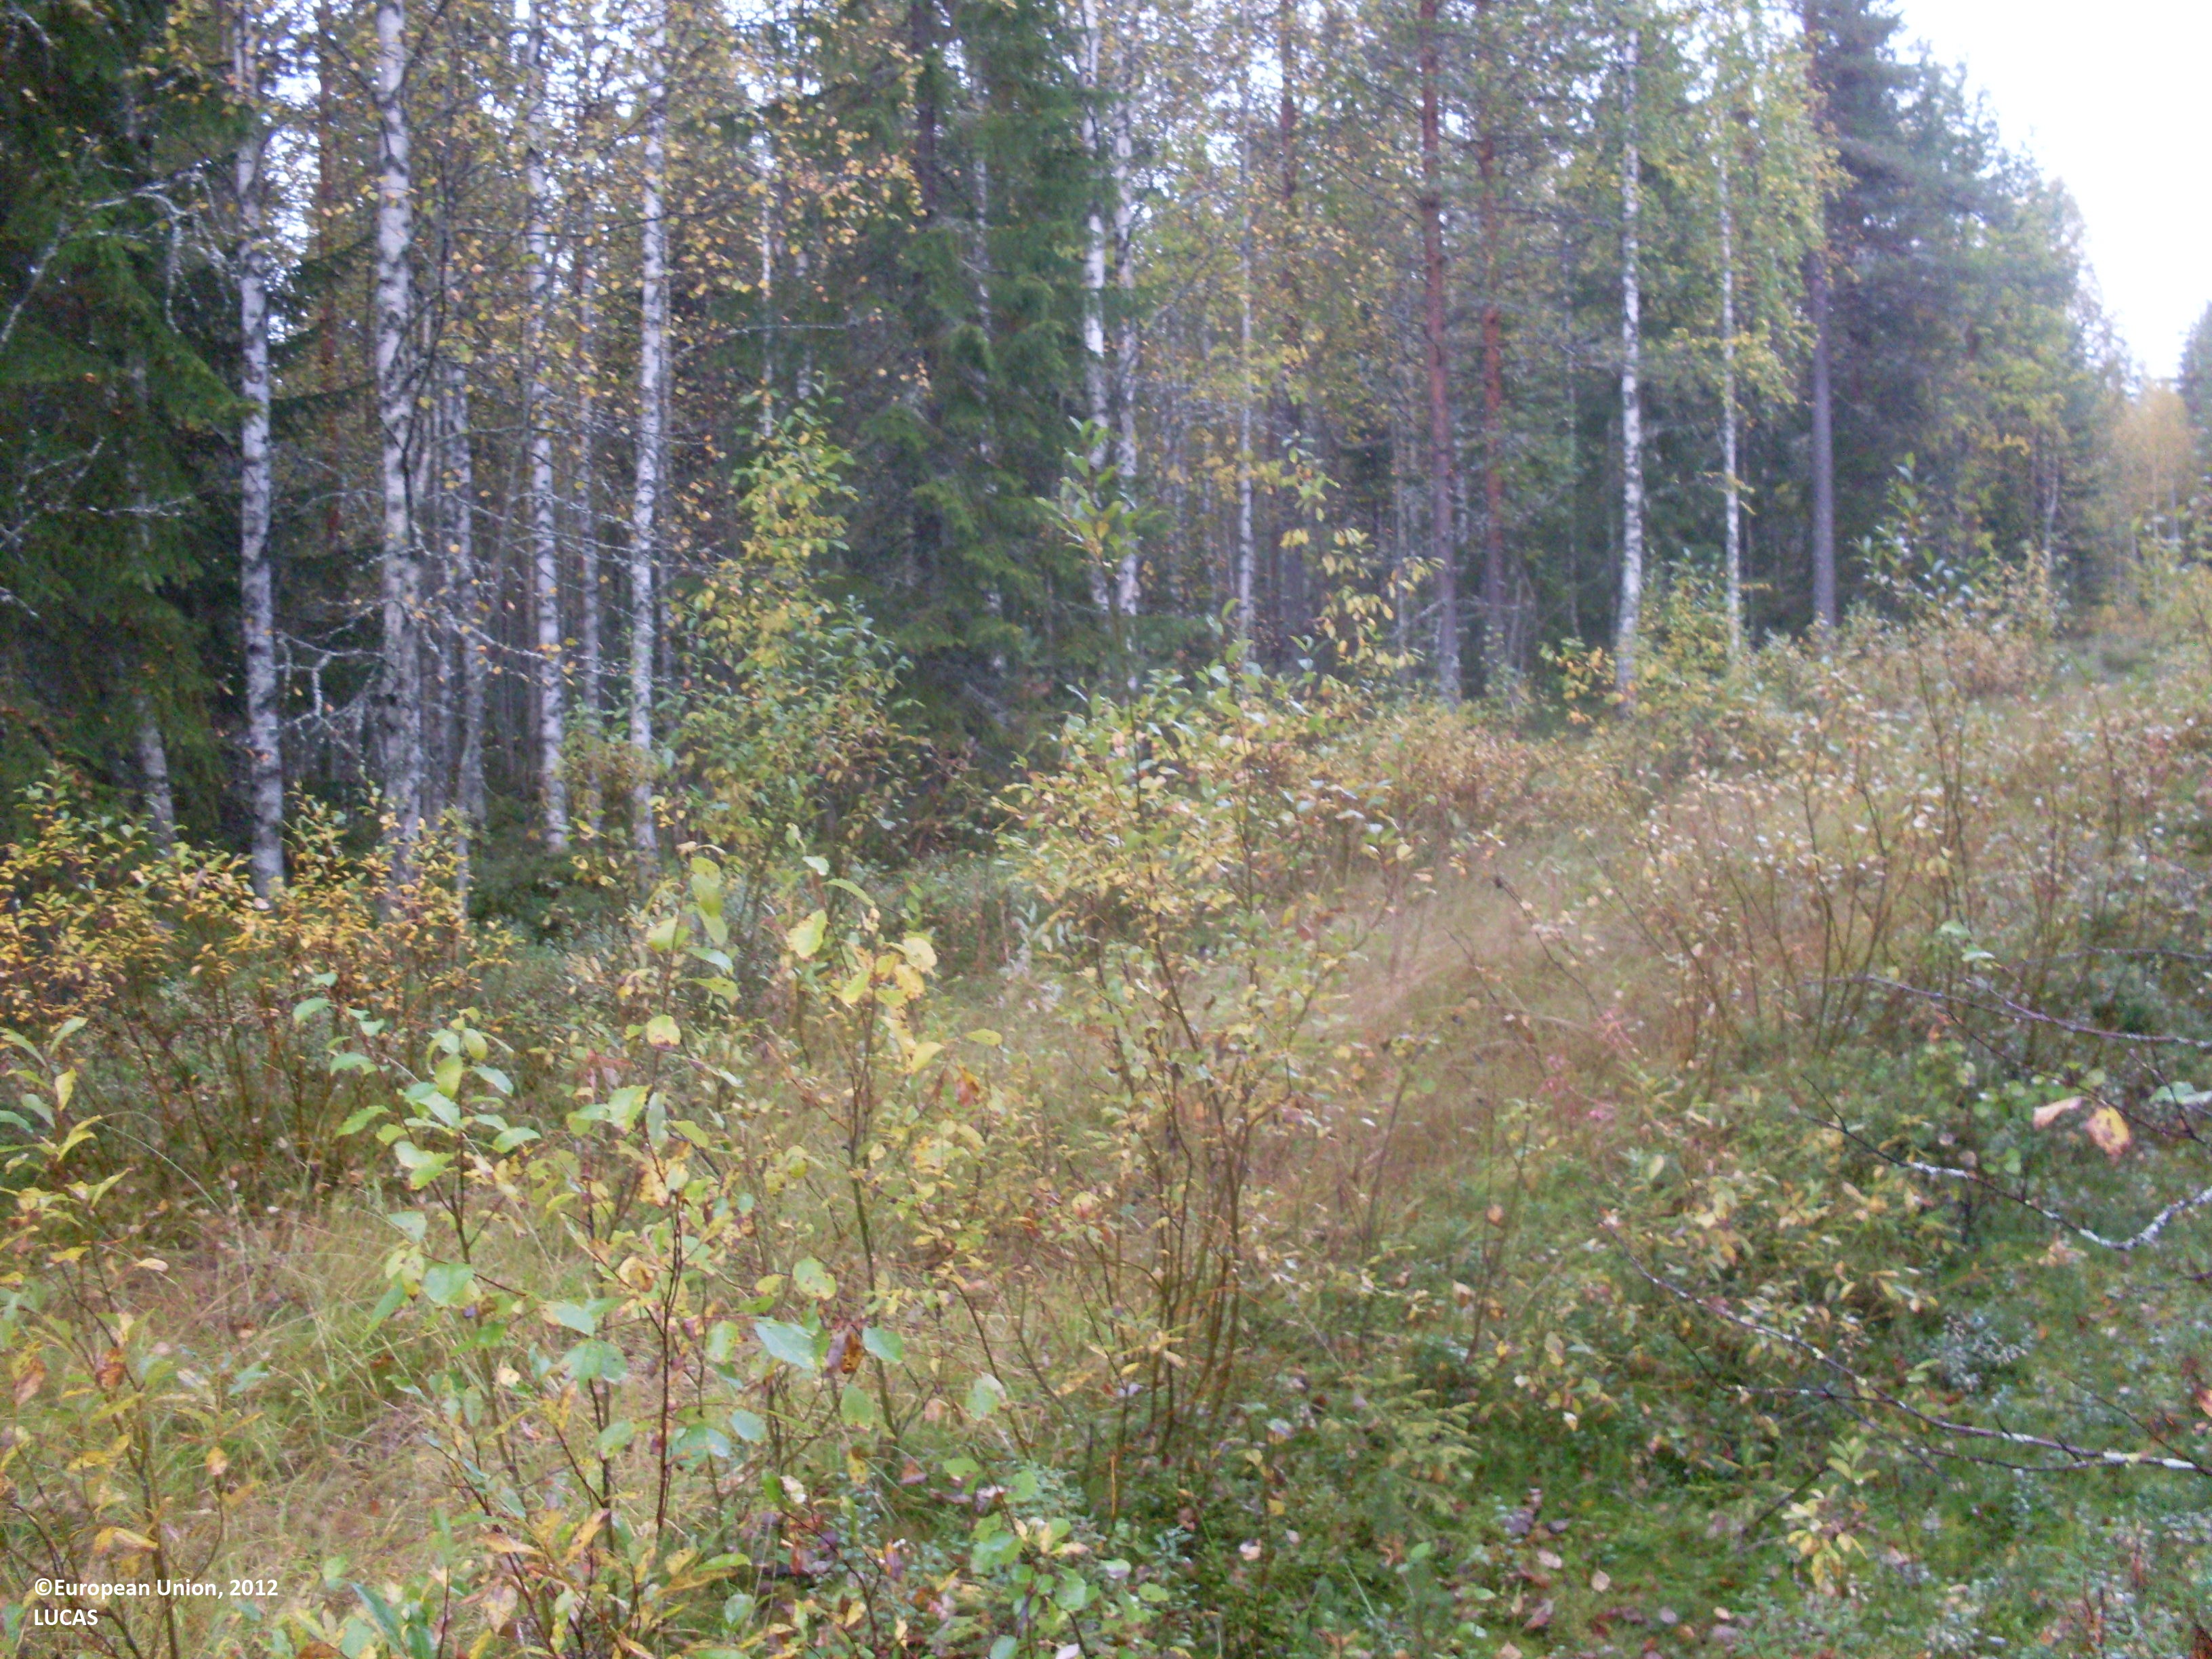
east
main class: Woodland
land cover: Other mixed woodland
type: boreal forest
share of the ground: > 75 %
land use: Forestry
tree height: > 5 m
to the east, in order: Other mixed woodland; Tracks; Other mixed woodland
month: September
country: FI
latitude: 64.0336
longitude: 29.9088
